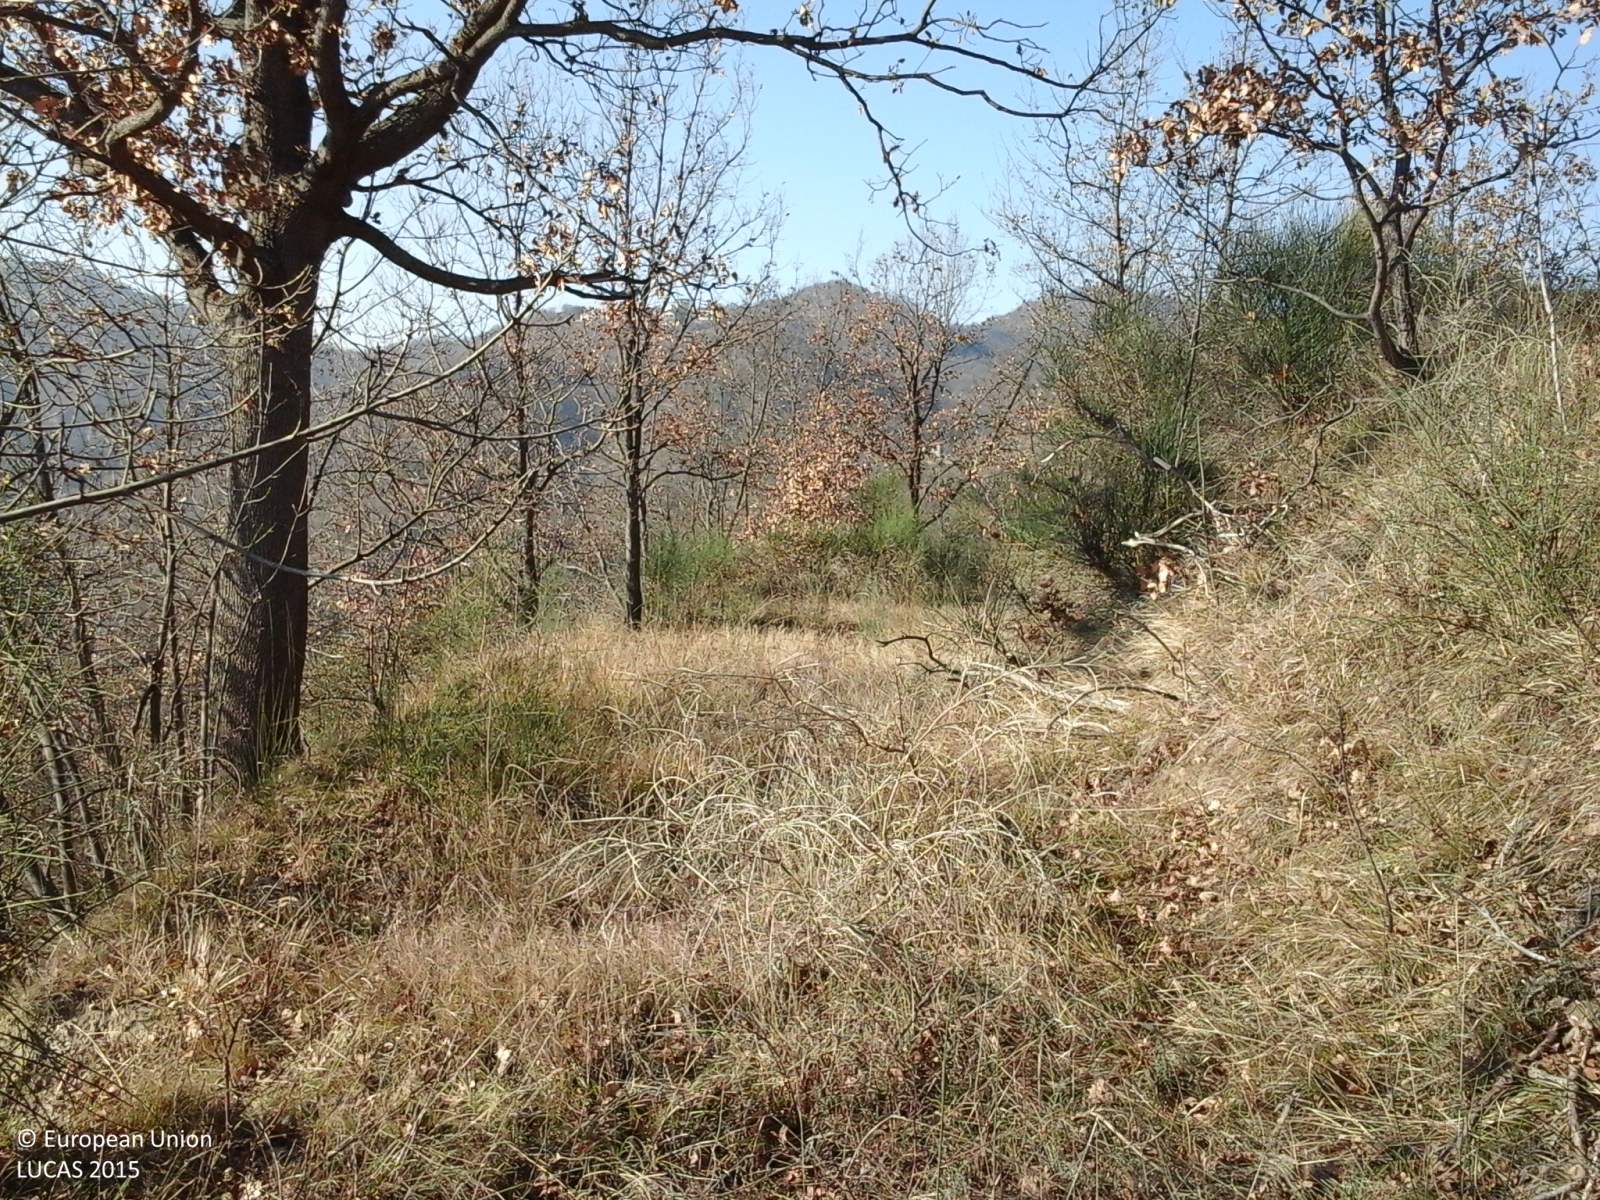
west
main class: Woodland
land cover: Broadleaved woodland
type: thermophilous deciduous forest
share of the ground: > 75 %
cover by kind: broadleaved forest trees 80 %, coniferous forest trees 20 %
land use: Forestry
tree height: > 5 m
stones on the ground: 10 - 25 %
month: January
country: IT
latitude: 44.4622
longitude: 8.2567
